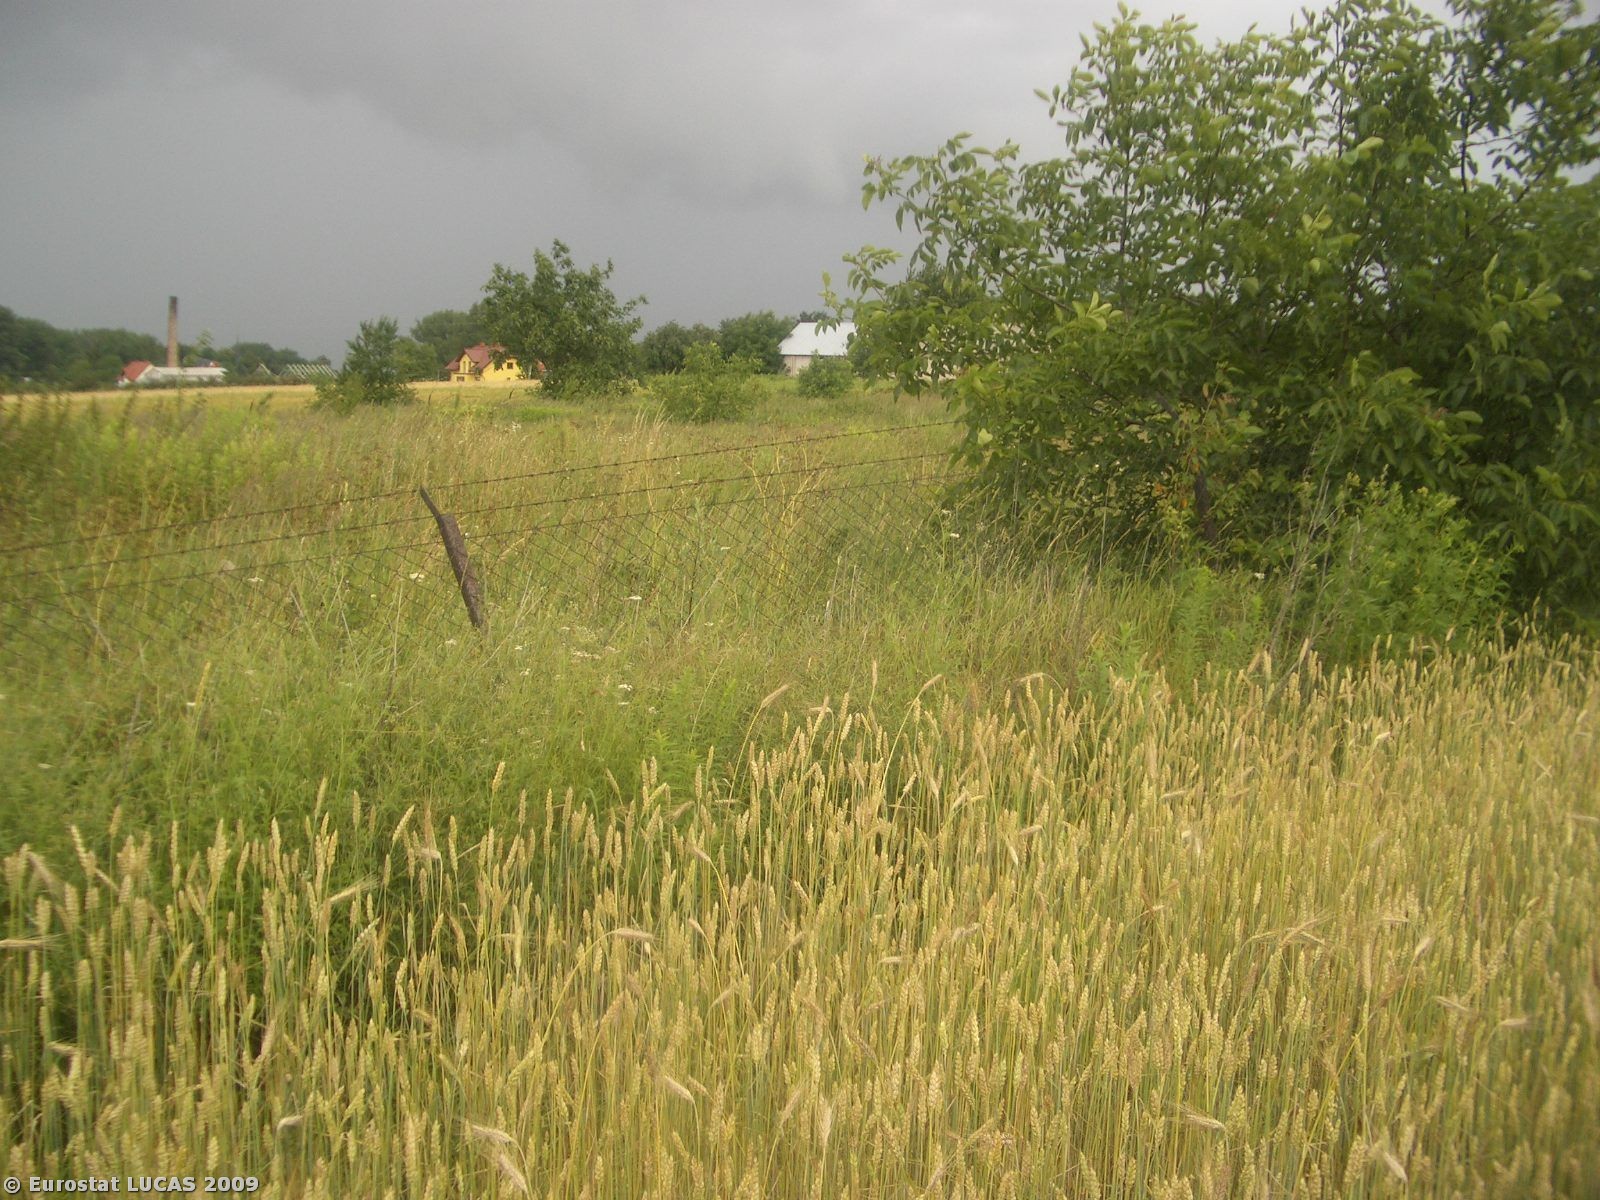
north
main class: Cropland
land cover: Triticale
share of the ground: 25 - 50 %
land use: Agriculture (excluding fallow land and kitchen gardens)
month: September
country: PL
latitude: 51.2717
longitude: 22.3771
